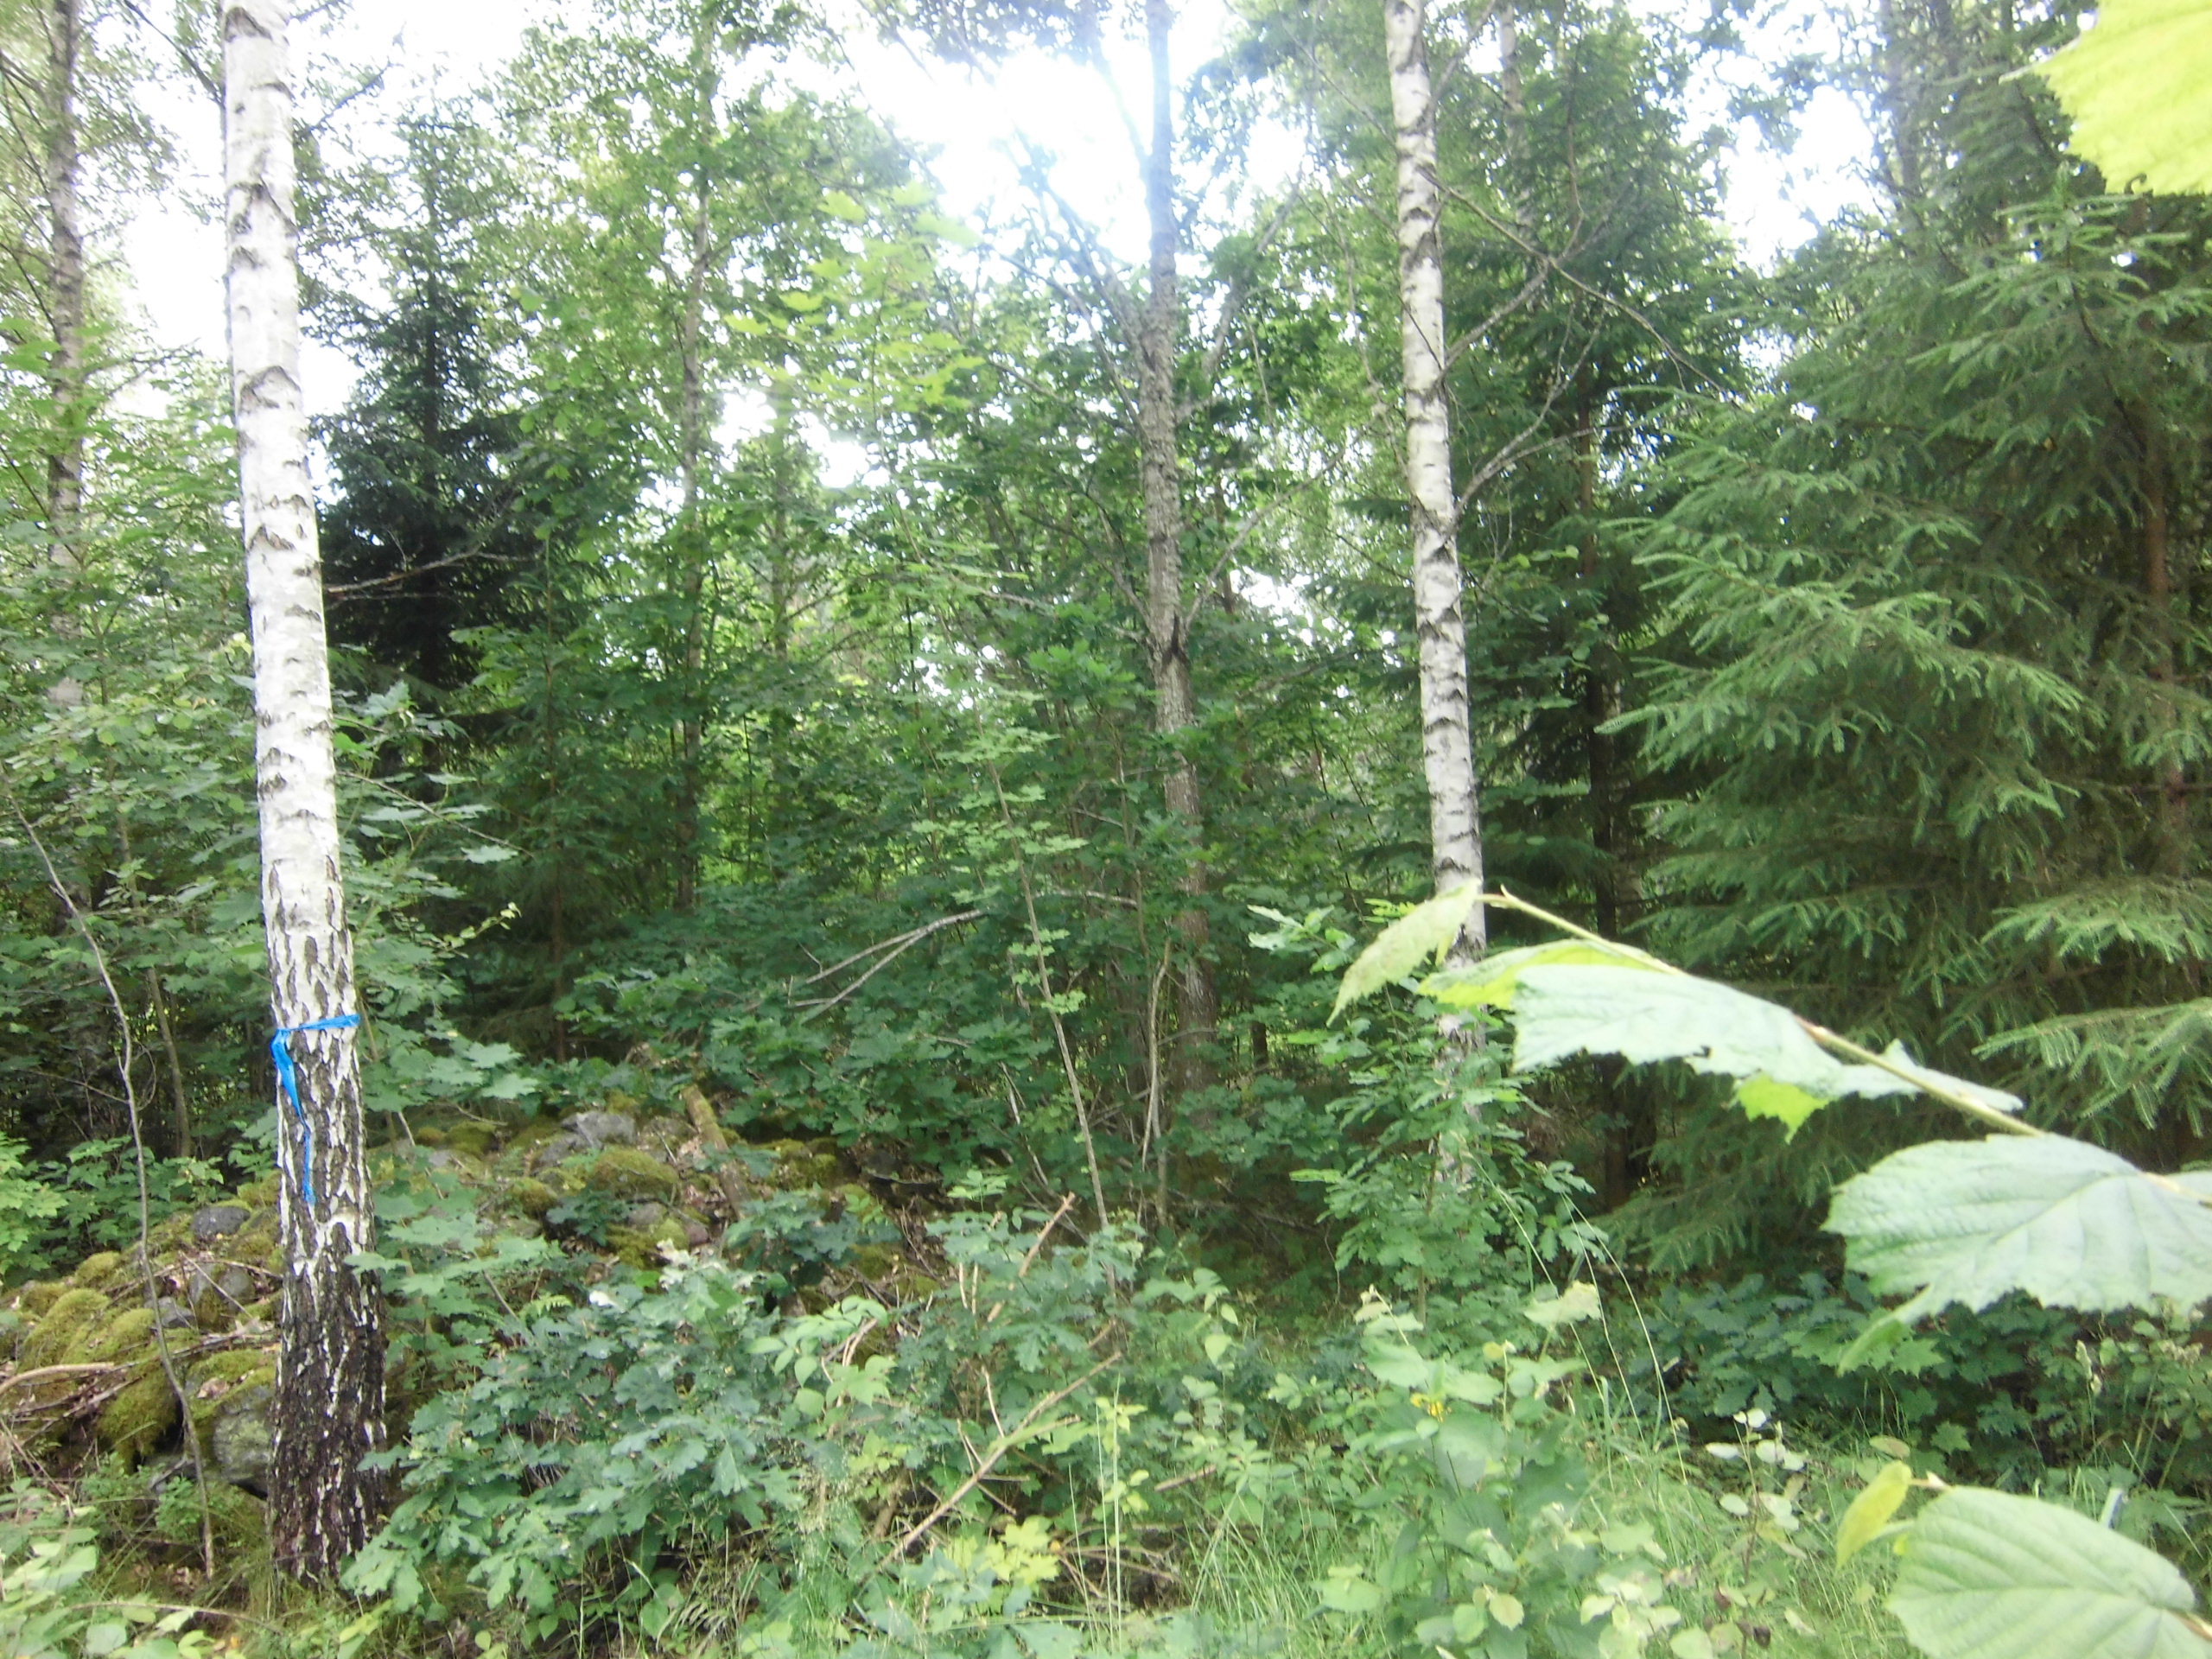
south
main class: Woodland
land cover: Broadleaved woodland
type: hemiboreal forest and nemoral coniferous forest and mixed broadleaved-coniferous forest
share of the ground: 50 - 75 %
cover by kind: broadleaved forest trees 55 %, herbaceous plants 25 %, shrubs 10 %, coniferous forest trees 5 %, lichens and mosses 5 %
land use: Forestry
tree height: > 5 m
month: July
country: SE
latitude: 57.2202
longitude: 15.5785
